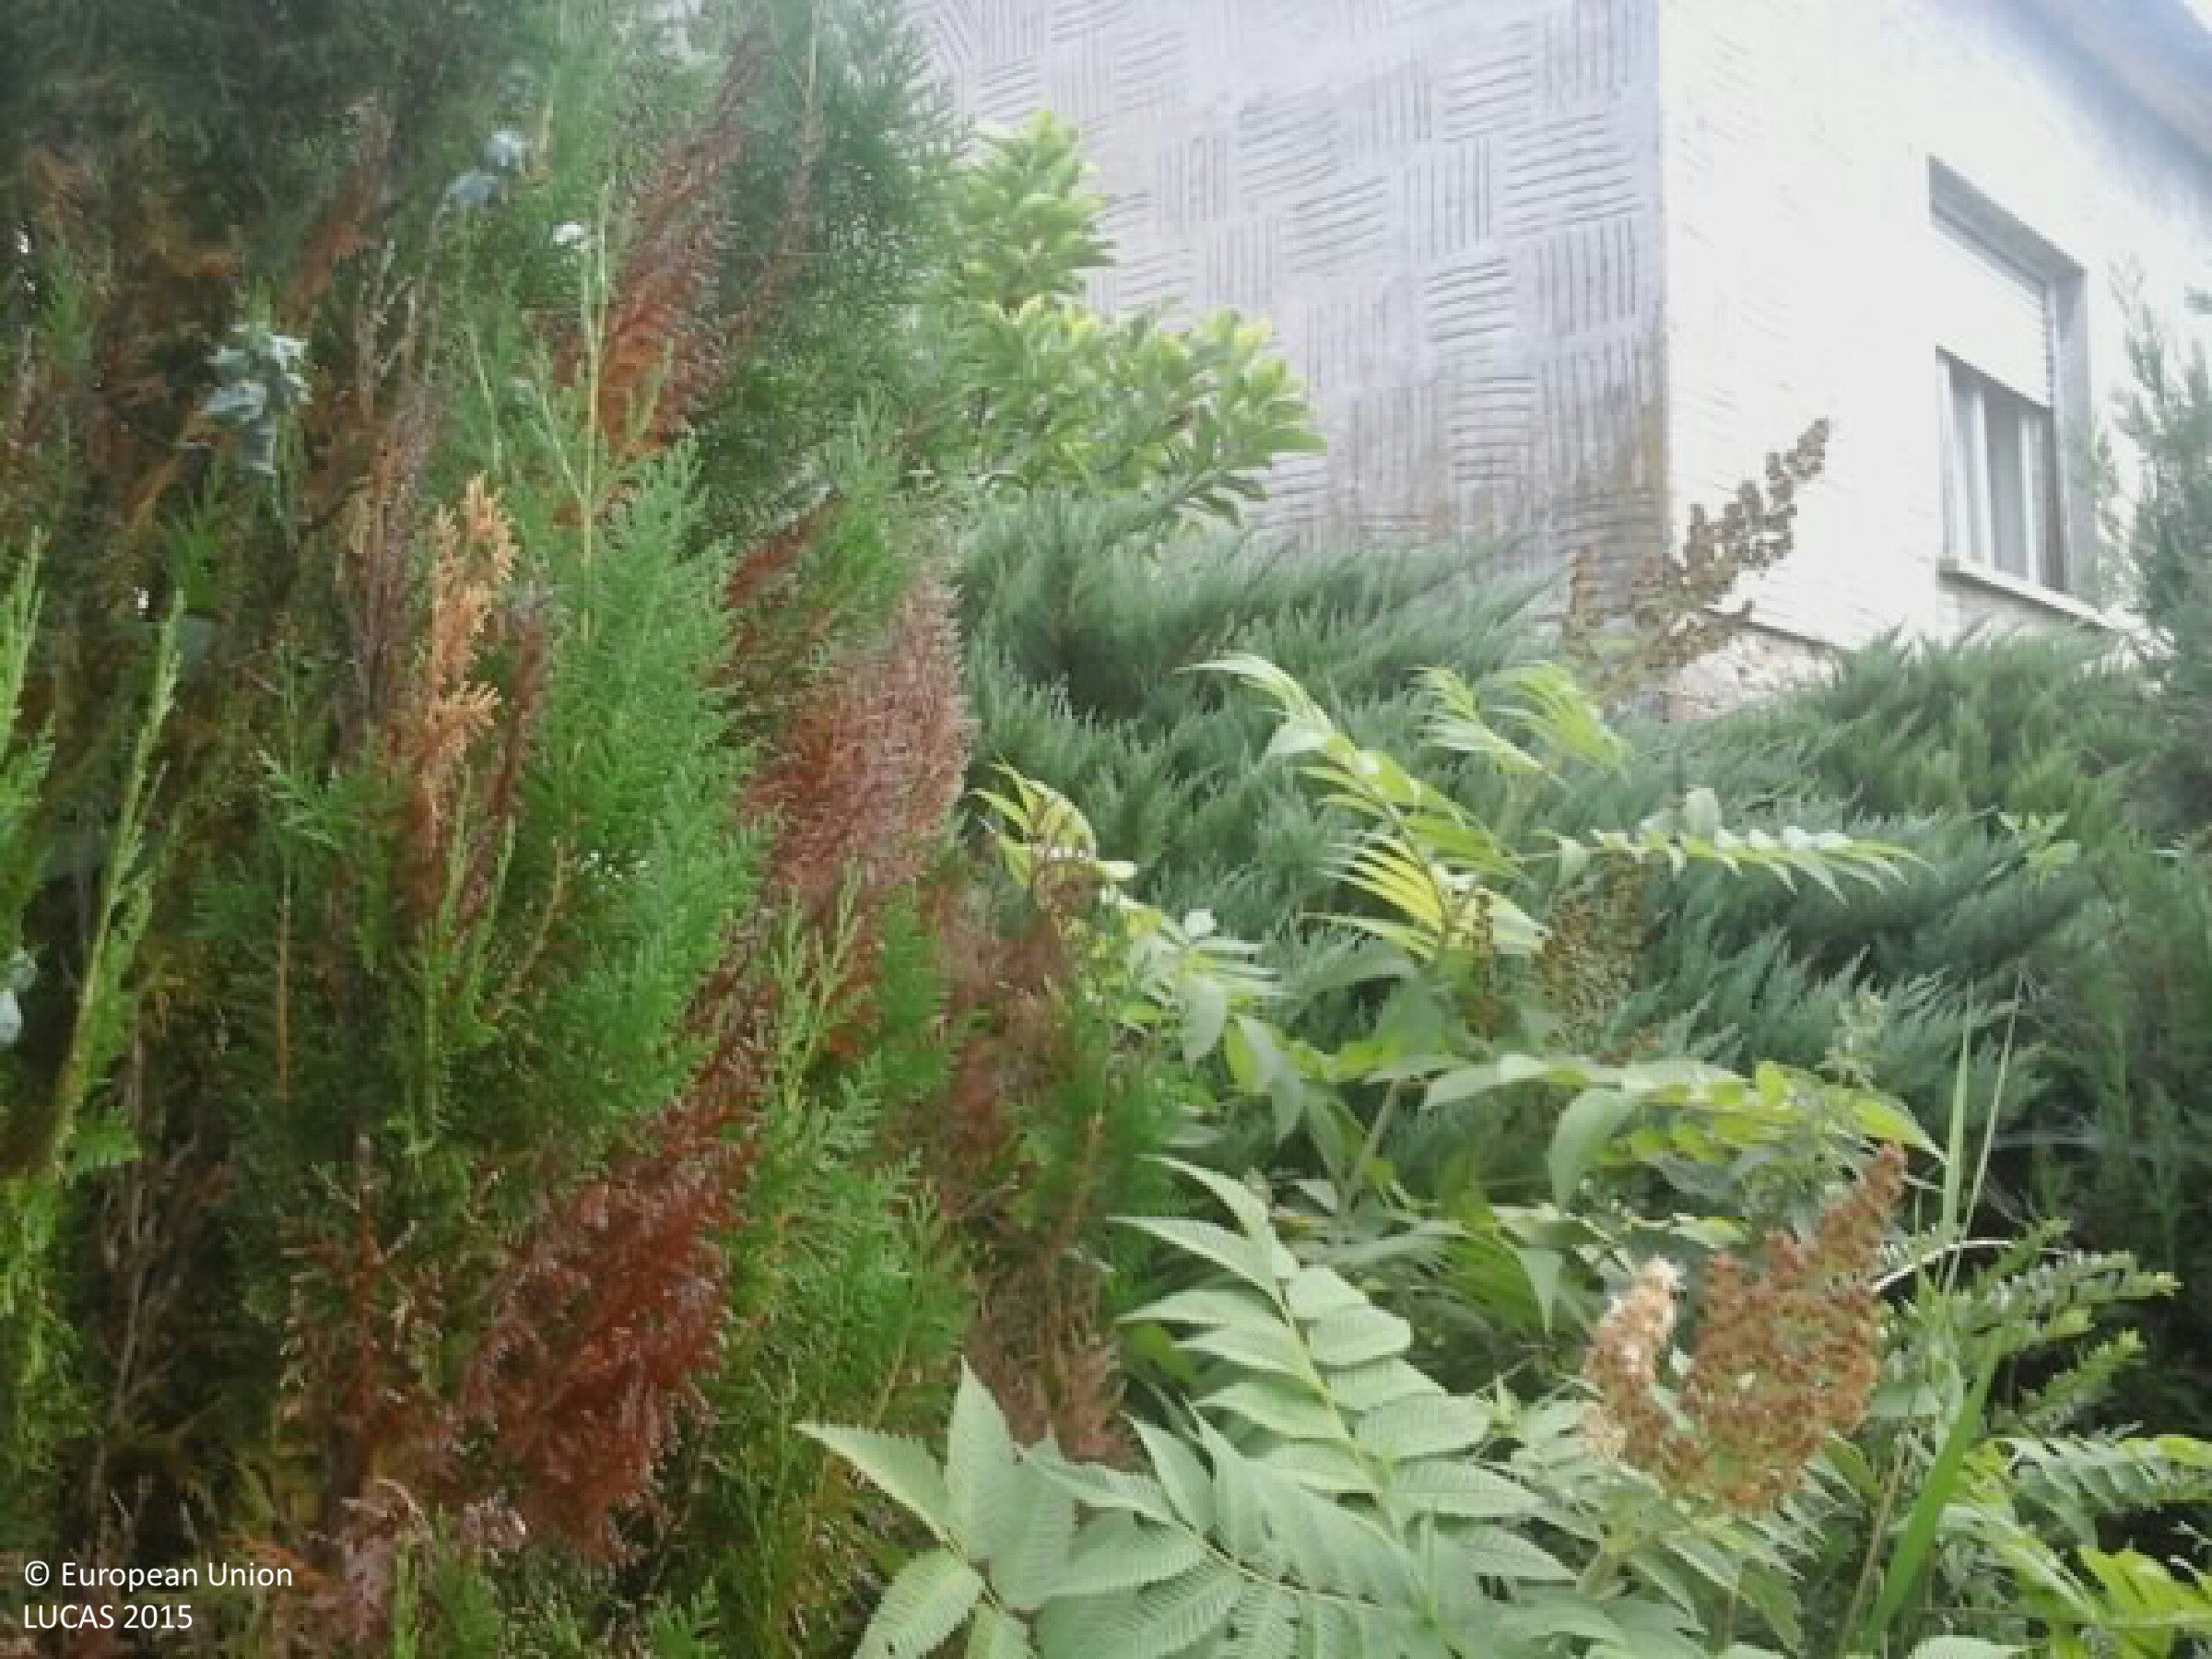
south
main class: Cropland
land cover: Floriculture and ornamental plants
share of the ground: > 75 %
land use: Kitchen garden
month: August
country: HU
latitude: 46.2359
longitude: 18.1901
